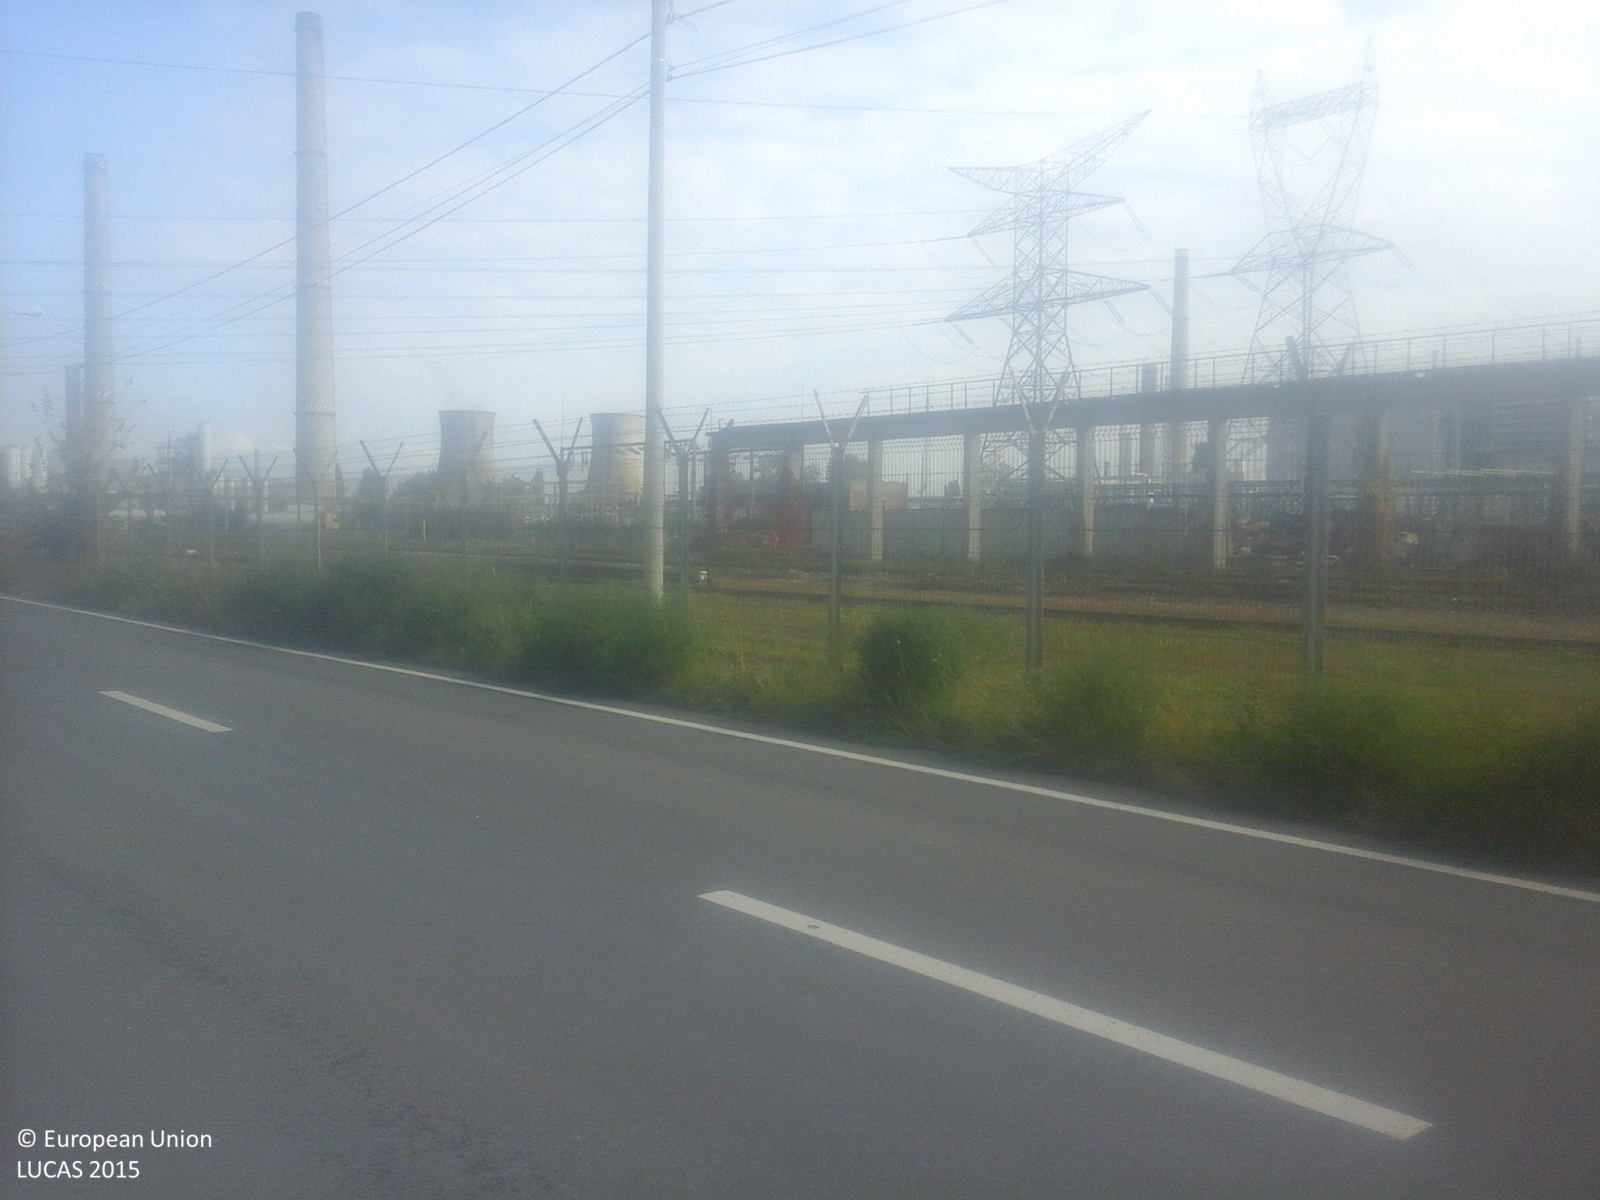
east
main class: Grassland
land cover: Spontaneously vegetated surfaces
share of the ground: > 75 %
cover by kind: herbaceous plants 100 %
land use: Fallow land
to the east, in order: Spontaneously vegetated surfaces; Artificial constructions in urban areas
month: October
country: RO
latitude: 44.8807
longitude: 25.9948
